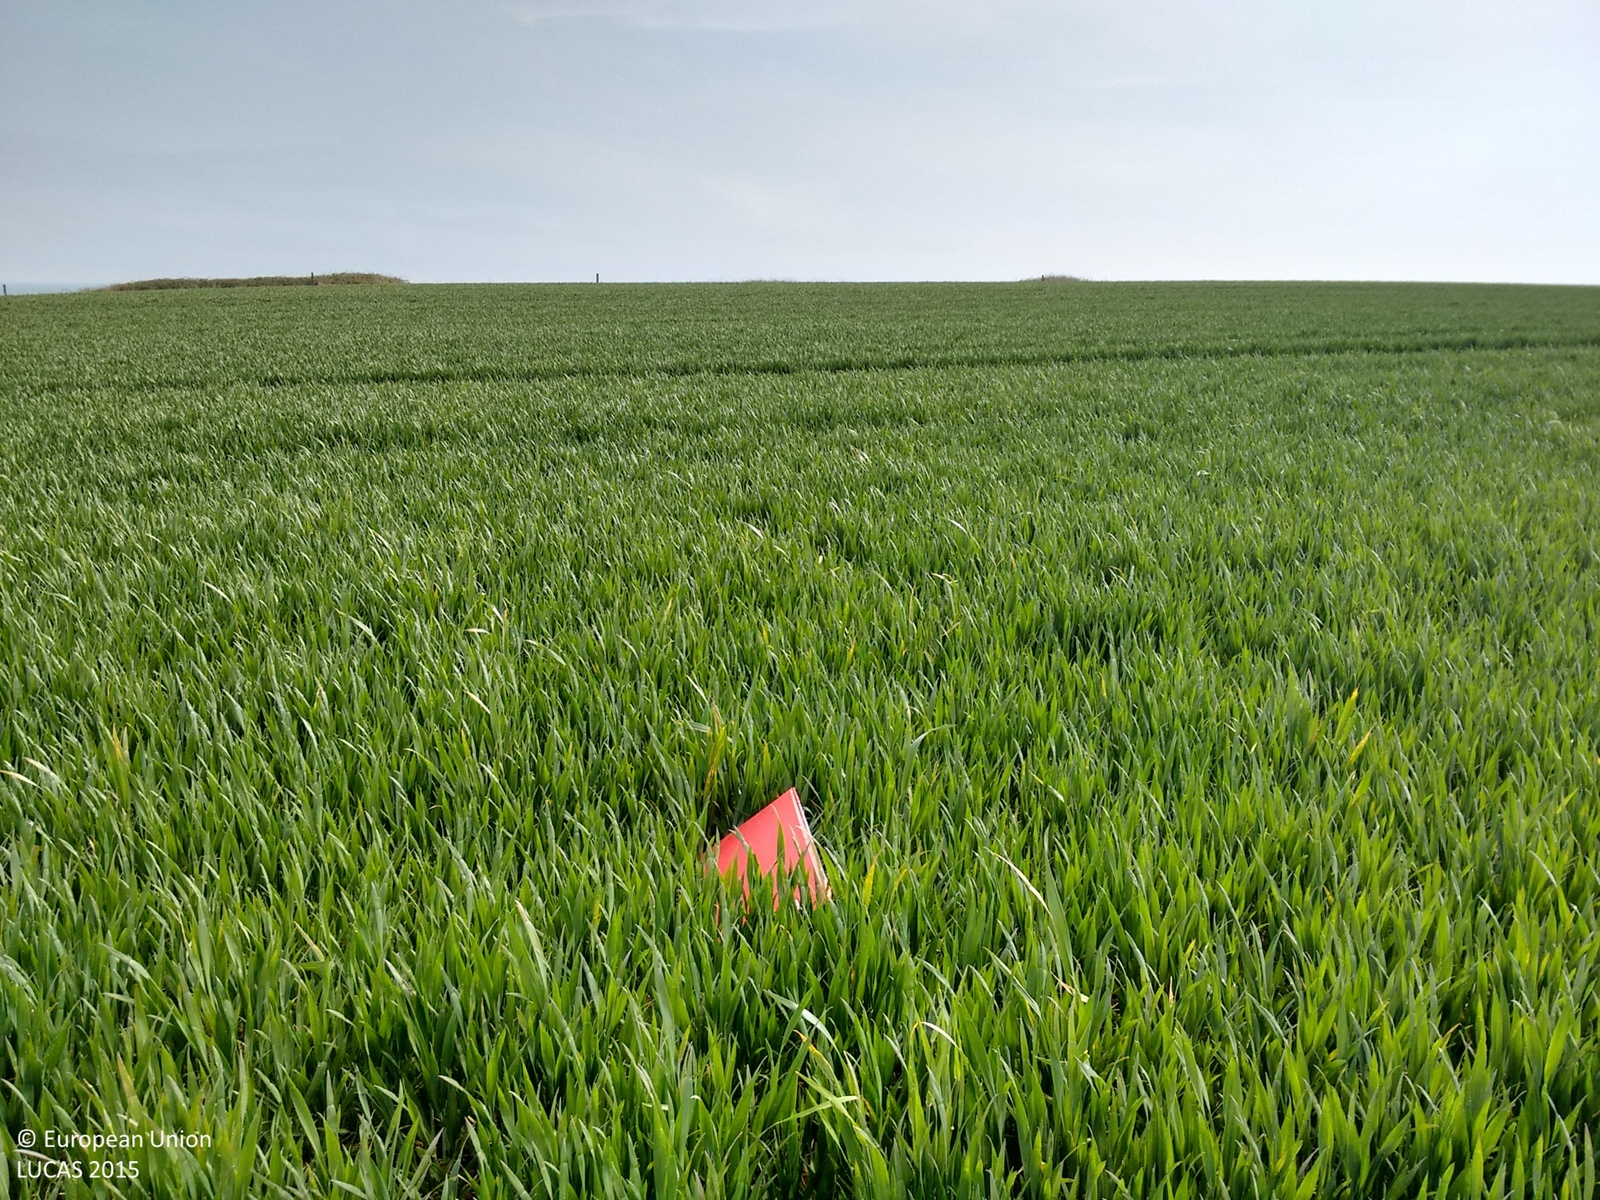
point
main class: Cropland
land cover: Common wheat
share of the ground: > 75 %
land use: Agriculture (excluding fallow land and kitchen gardens)
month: May
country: GB
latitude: 53.9848
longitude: -0.2051
